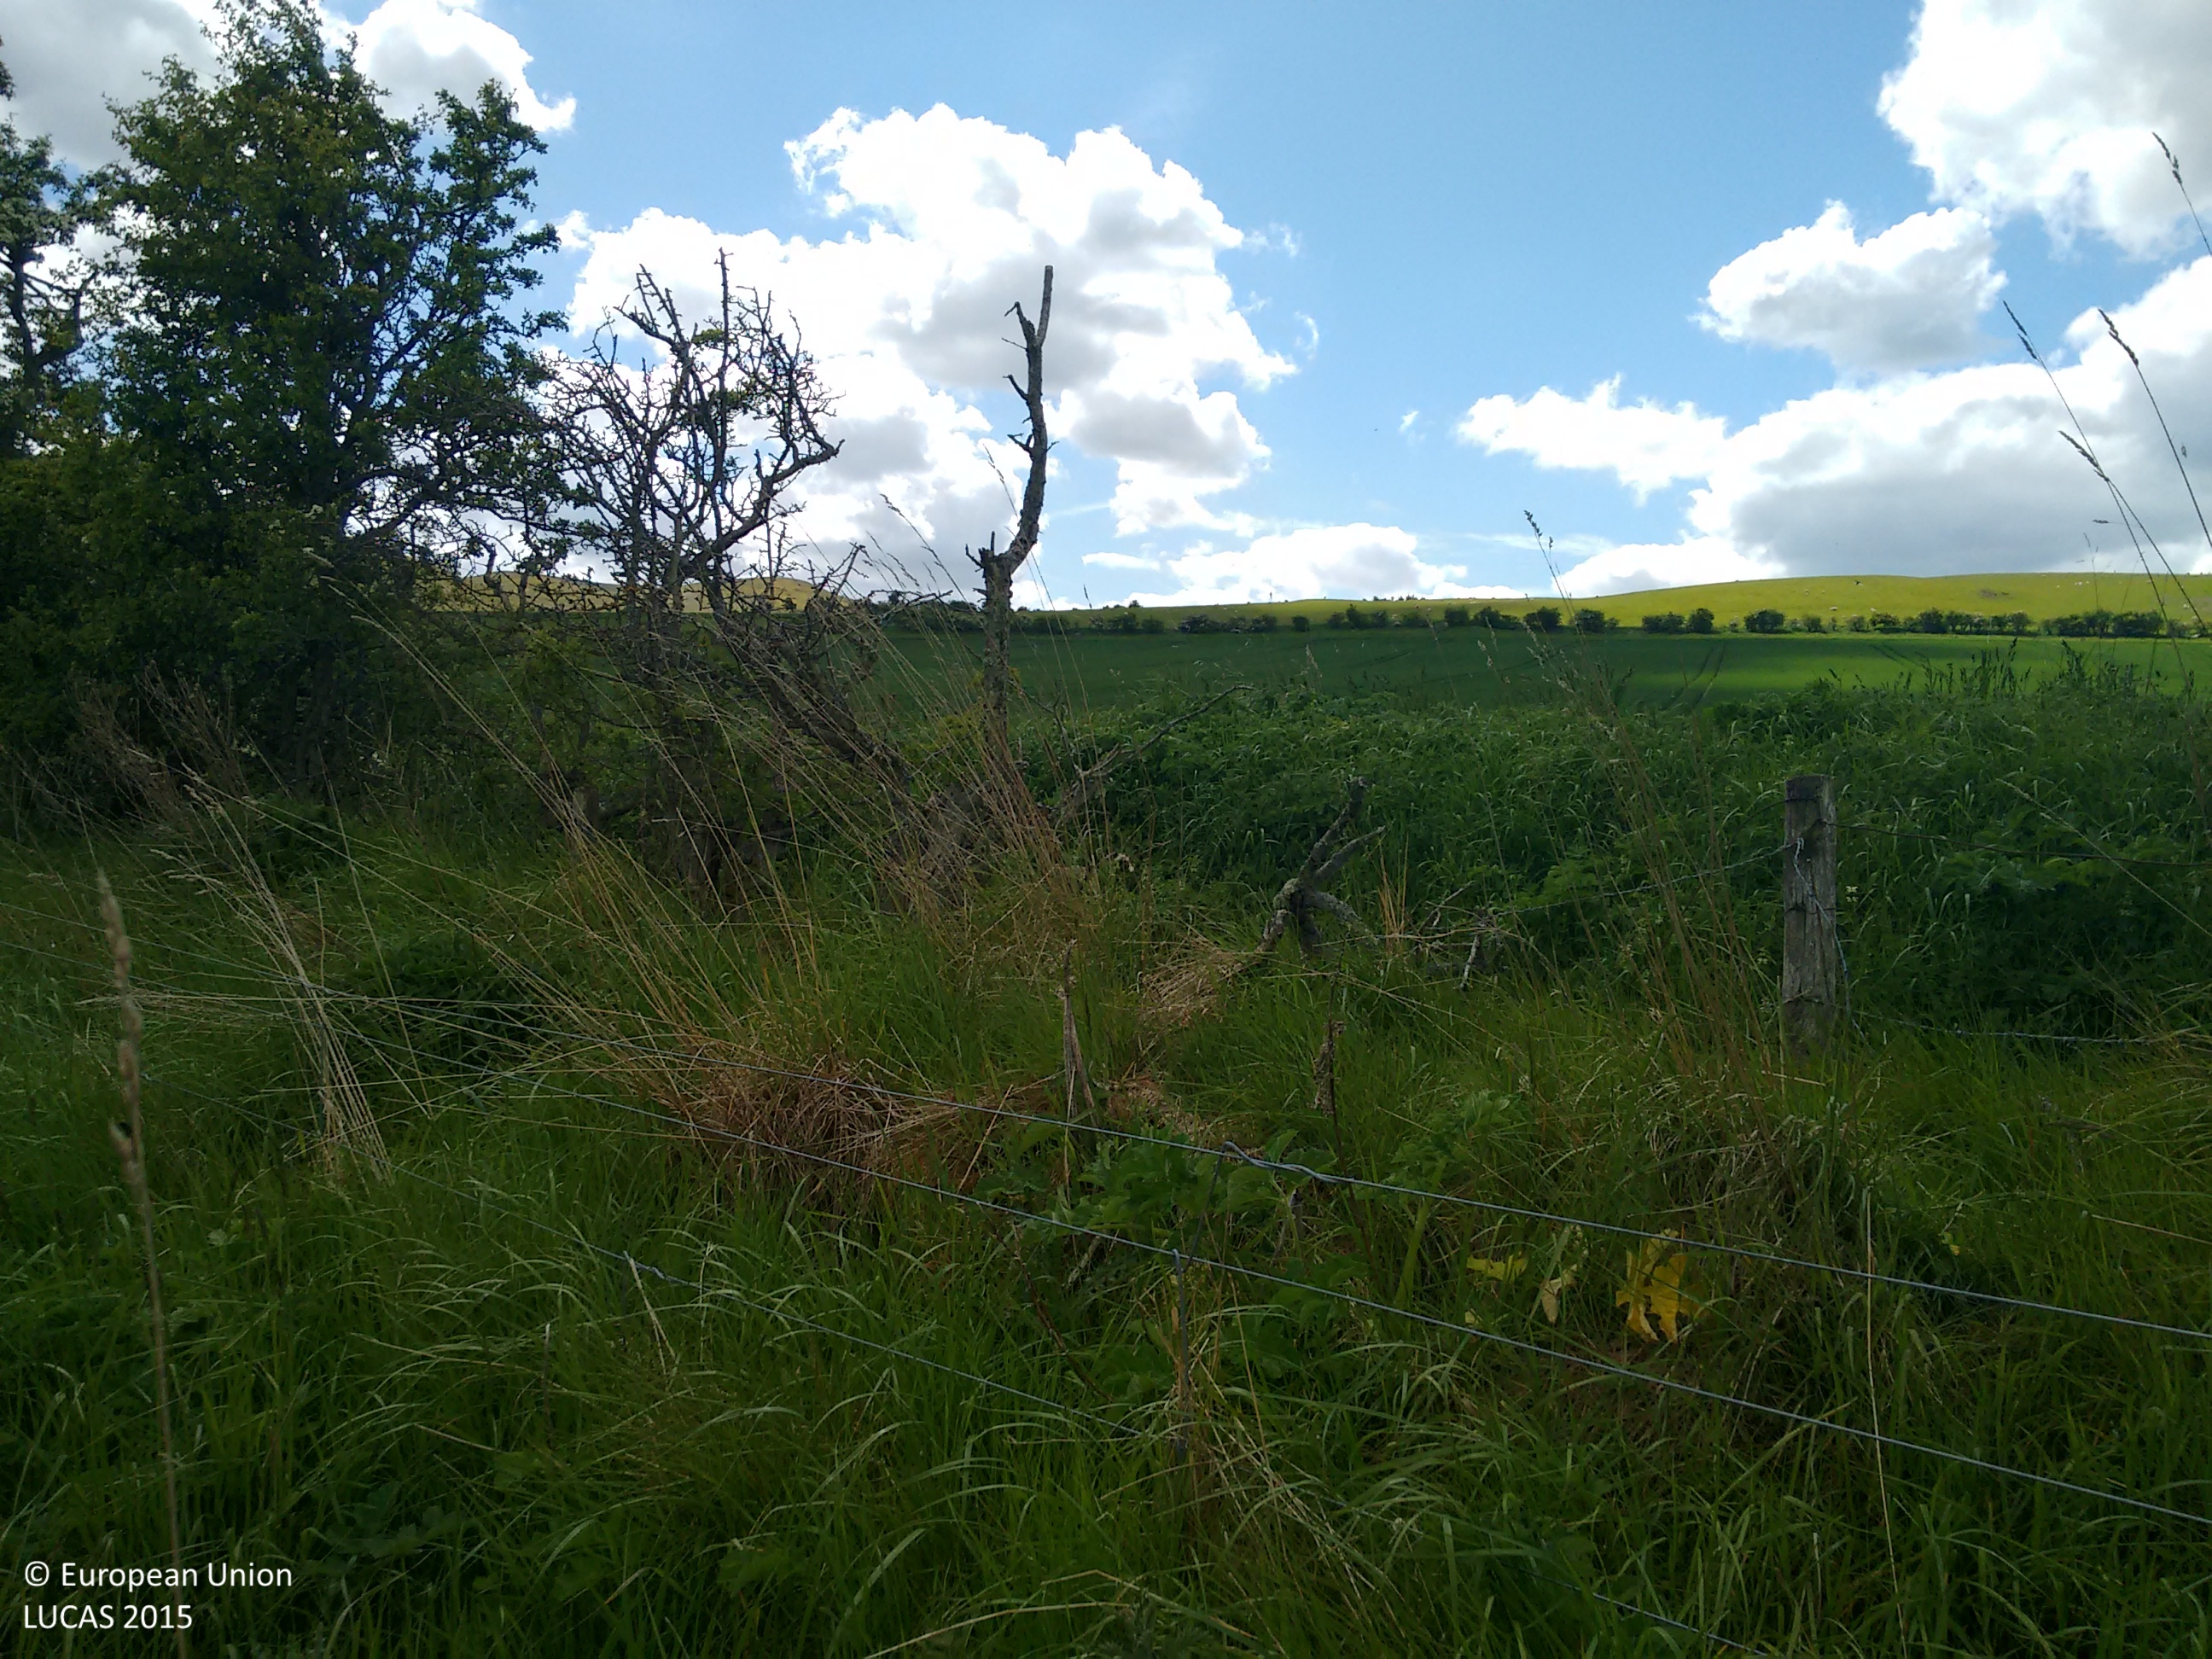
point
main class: Cropland
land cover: Barley
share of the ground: > 75 %
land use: Agriculture (excluding fallow land and kitchen gardens)
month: June
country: GB
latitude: 55.5855
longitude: -2.1926
